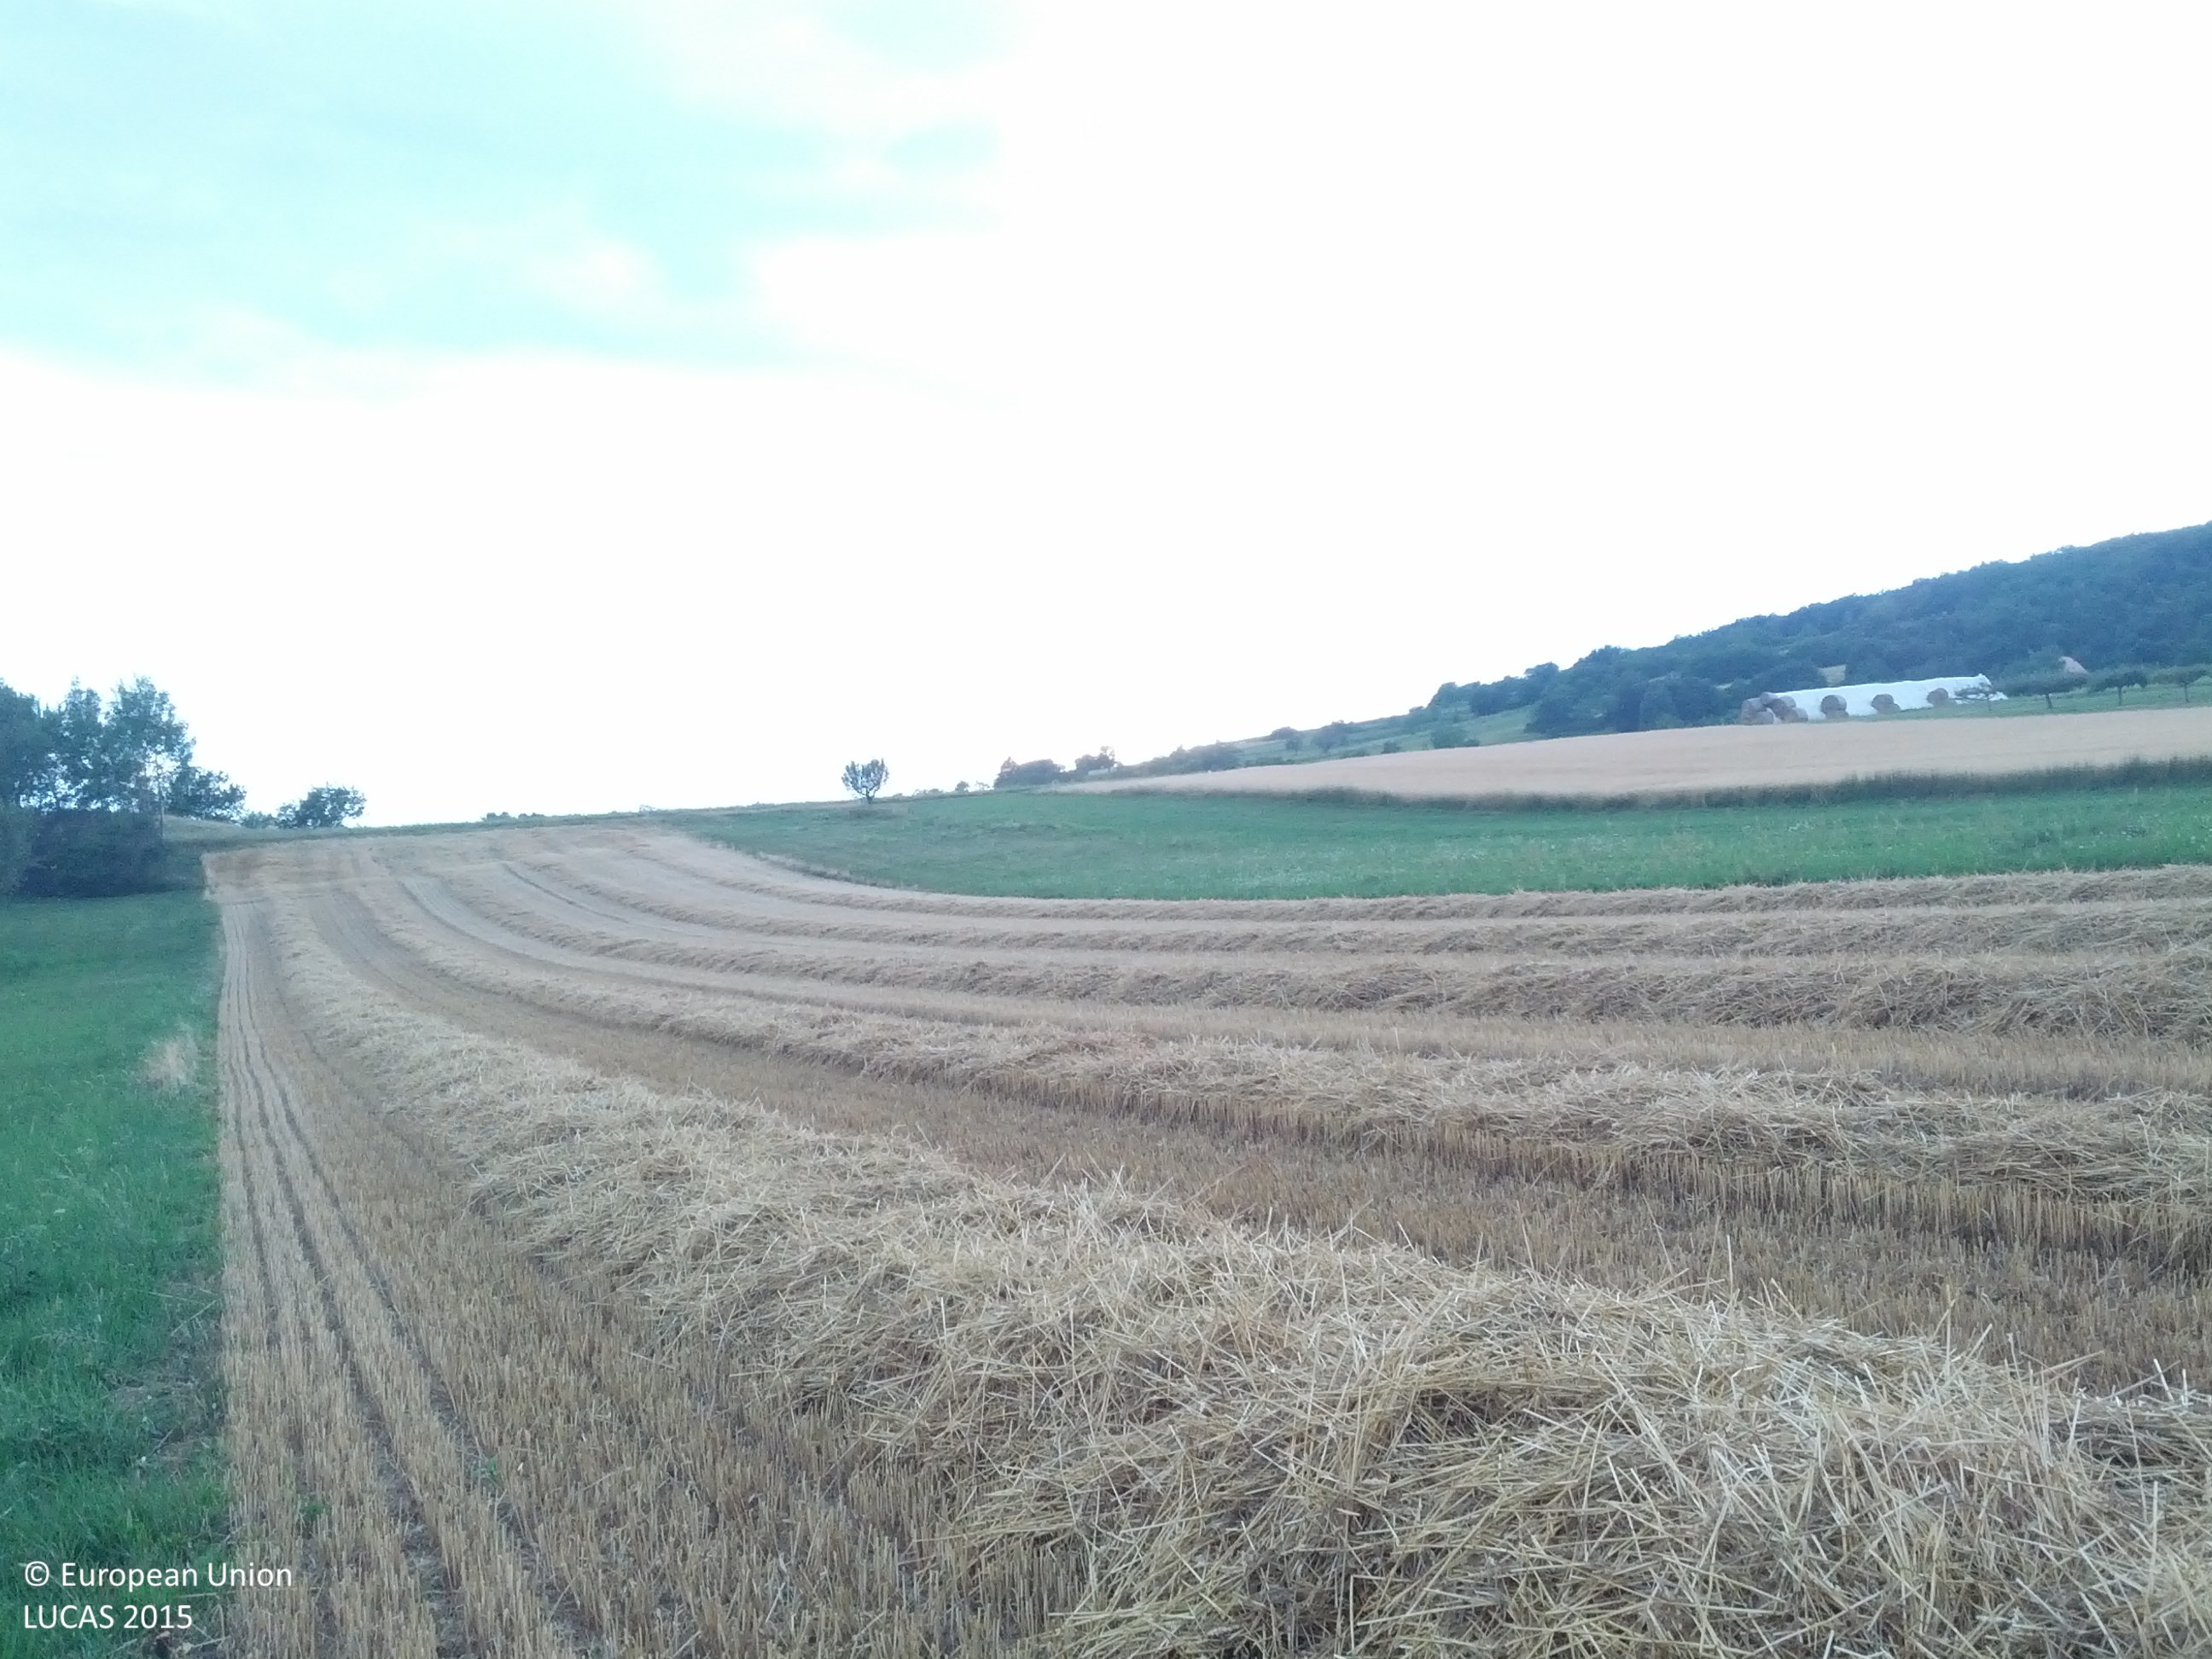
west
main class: Cropland
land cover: Common wheat
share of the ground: 10 - 25 %
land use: Agriculture (excluding fallow land and kitchen gardens)
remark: Harvested field
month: July
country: AT
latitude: 47.2979
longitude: 16.3904
